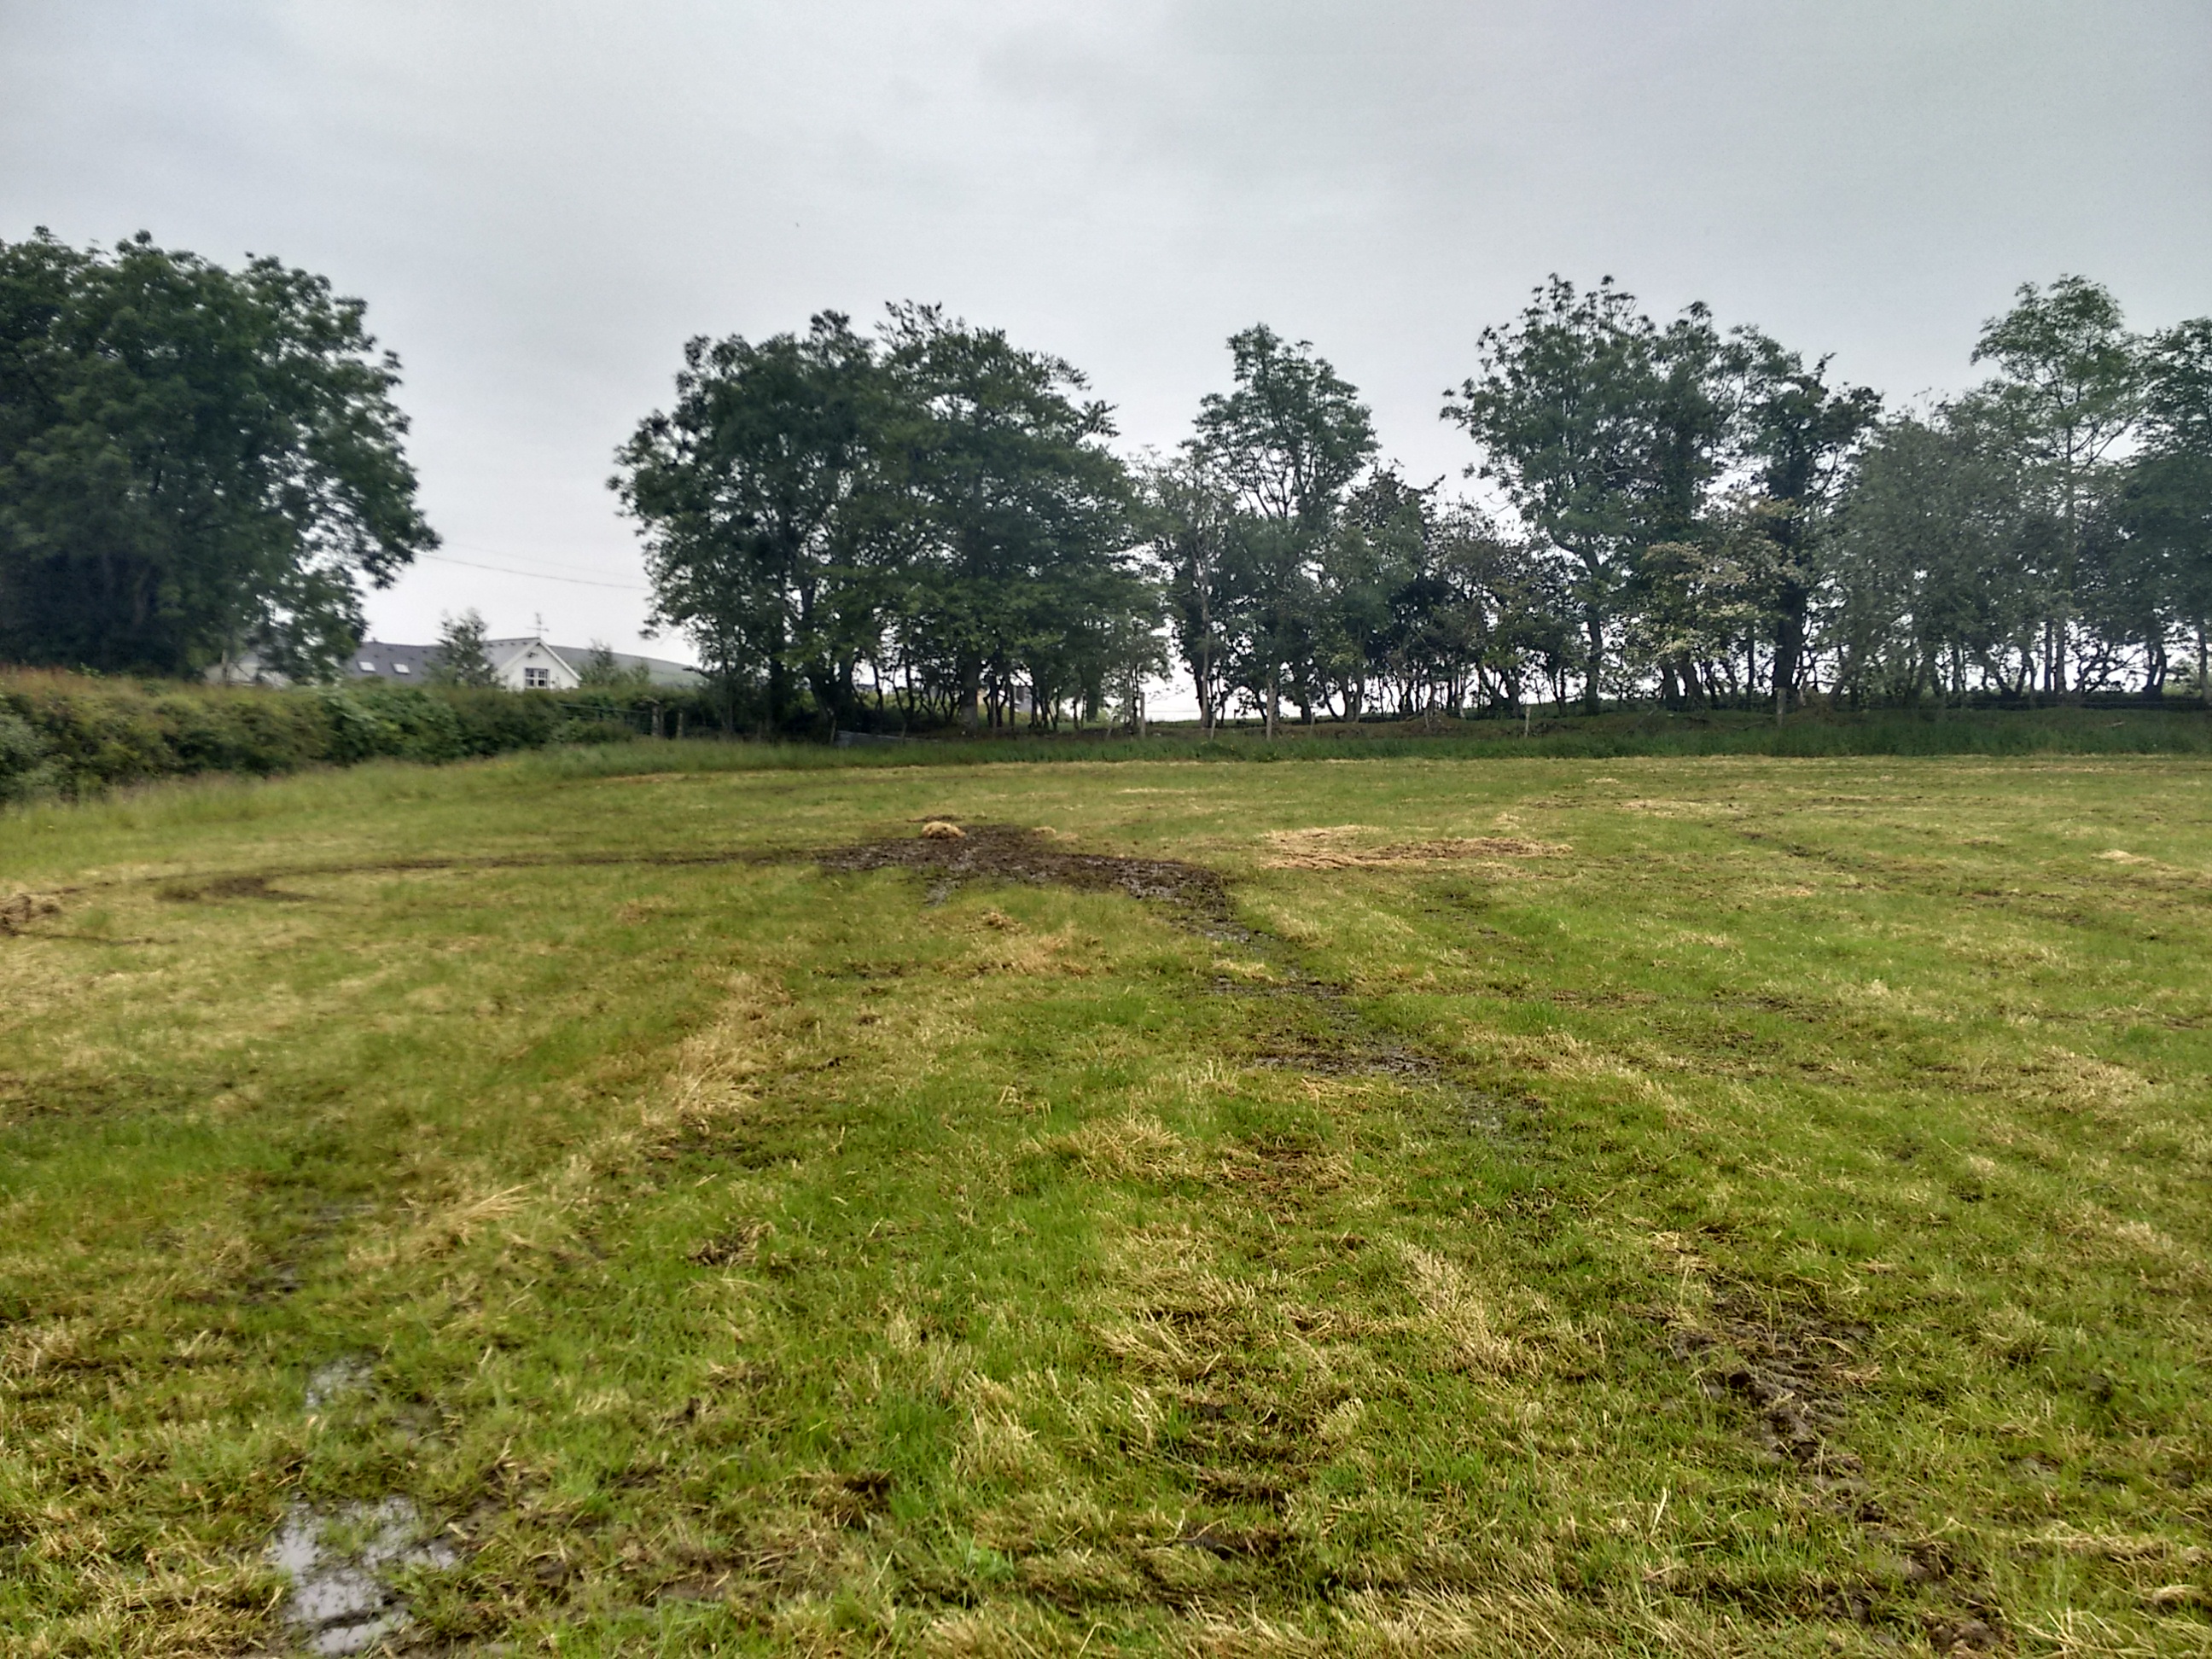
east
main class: Grassland
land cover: Grassland without tree/shrub cover
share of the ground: > 75 %
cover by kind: herbaceous plants 90 %, unconsolidated bare surface 10 %
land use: Agriculture (excluding fallow land and kitchen gardens)
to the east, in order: Grassland without tree/shrub cover; Fences; Abandoned hedges; Grassland without tree/shrub cover; Abandoned hedges; Grassland without tree/shrub cover; Managed hedges; Grass margins; Paved roads, cycling and walking lanes; Grass margins; Artificial constructions in urban areas; Managed hedges; Paved roads, cycling and walking lanes; Grass margins; Managed hedges; Fences; Grassland without tree/shrub cover; Ditches and canals; Grass margins; Fences; Grass margins; Paved roads, cycling and walking lanes; Grass margins; Abandoned hedges; Fences; Grassland without tree/shrub cover
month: June
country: GB
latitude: 54.7431
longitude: -7.2816
